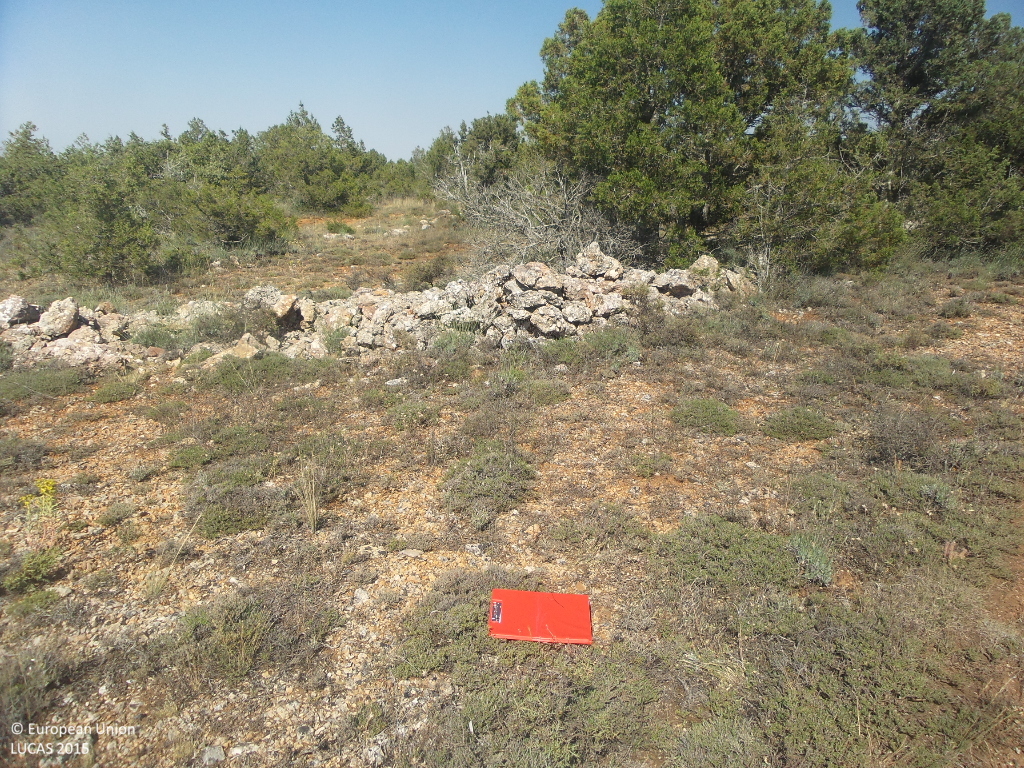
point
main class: Woodland
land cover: Other coniferous woodland
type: coniferous forest of the mediterranean region
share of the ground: 10 - 25 %
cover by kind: unconsolidated bare surface 45 %, shrubs 35 %, coniferous forest trees 15 %, herbaceous plants 5 %
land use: Semi-natural and natural areas not in use
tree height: < 5 m
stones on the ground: 25 - 50 %
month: July
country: ES
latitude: 41.1208
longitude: -2.1163
